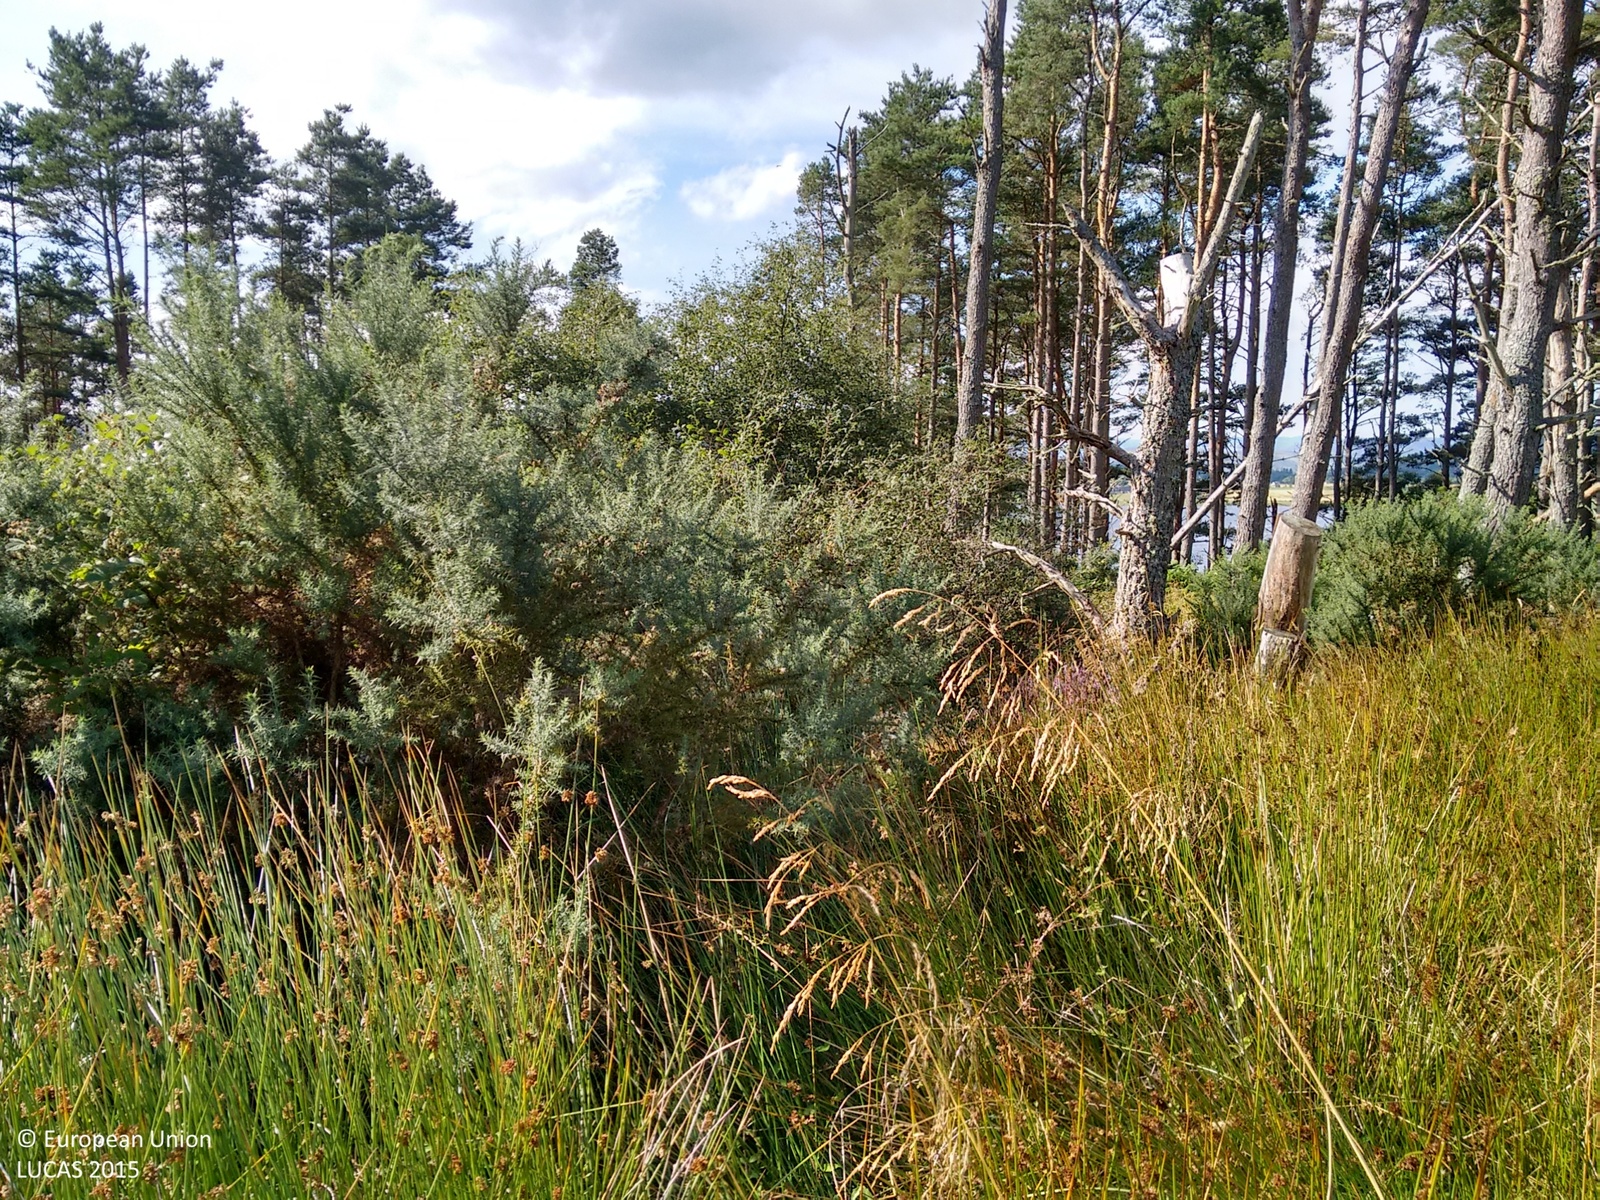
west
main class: Woodland
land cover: Pine dominated coniferous woodland
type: exotic forest
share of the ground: > 75 %
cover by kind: coniferous forest trees 80 %, shrubs 10 %, herbaceous plants 10 %
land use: Forestry
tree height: > 5 m
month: September
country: GB
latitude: 57.8848
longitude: -4.3363
